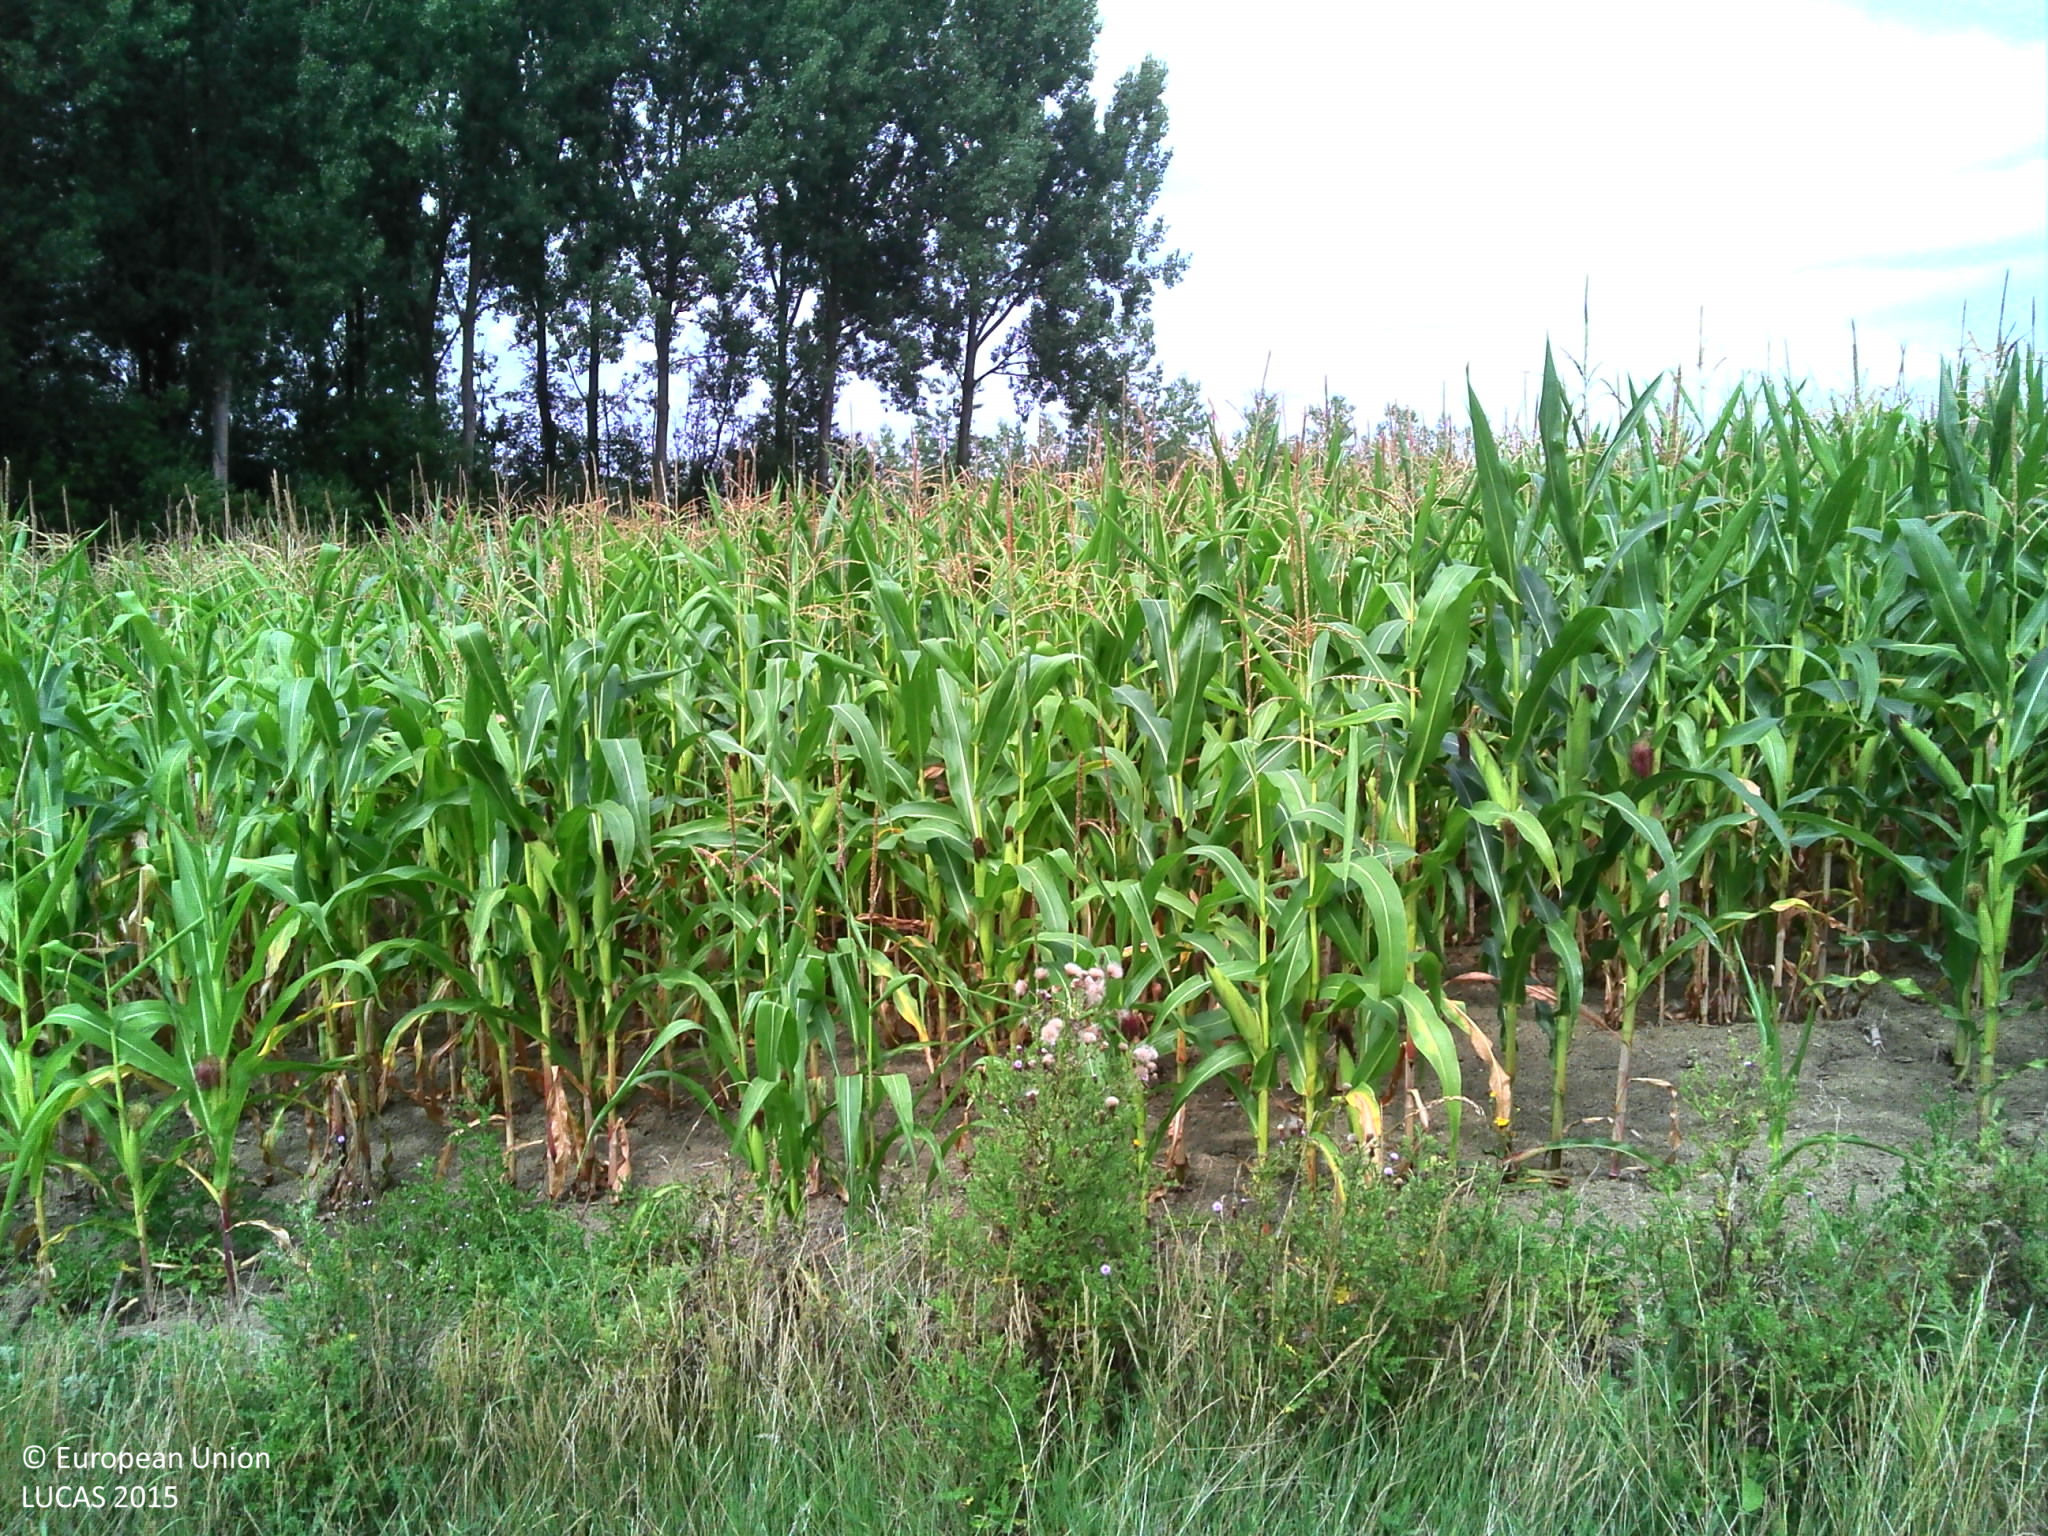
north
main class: Cropland
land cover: Maize
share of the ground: > 75 %
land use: Agriculture (excluding fallow land and kitchen gardens)
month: August
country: BE
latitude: 50.7067
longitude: 3.5779
